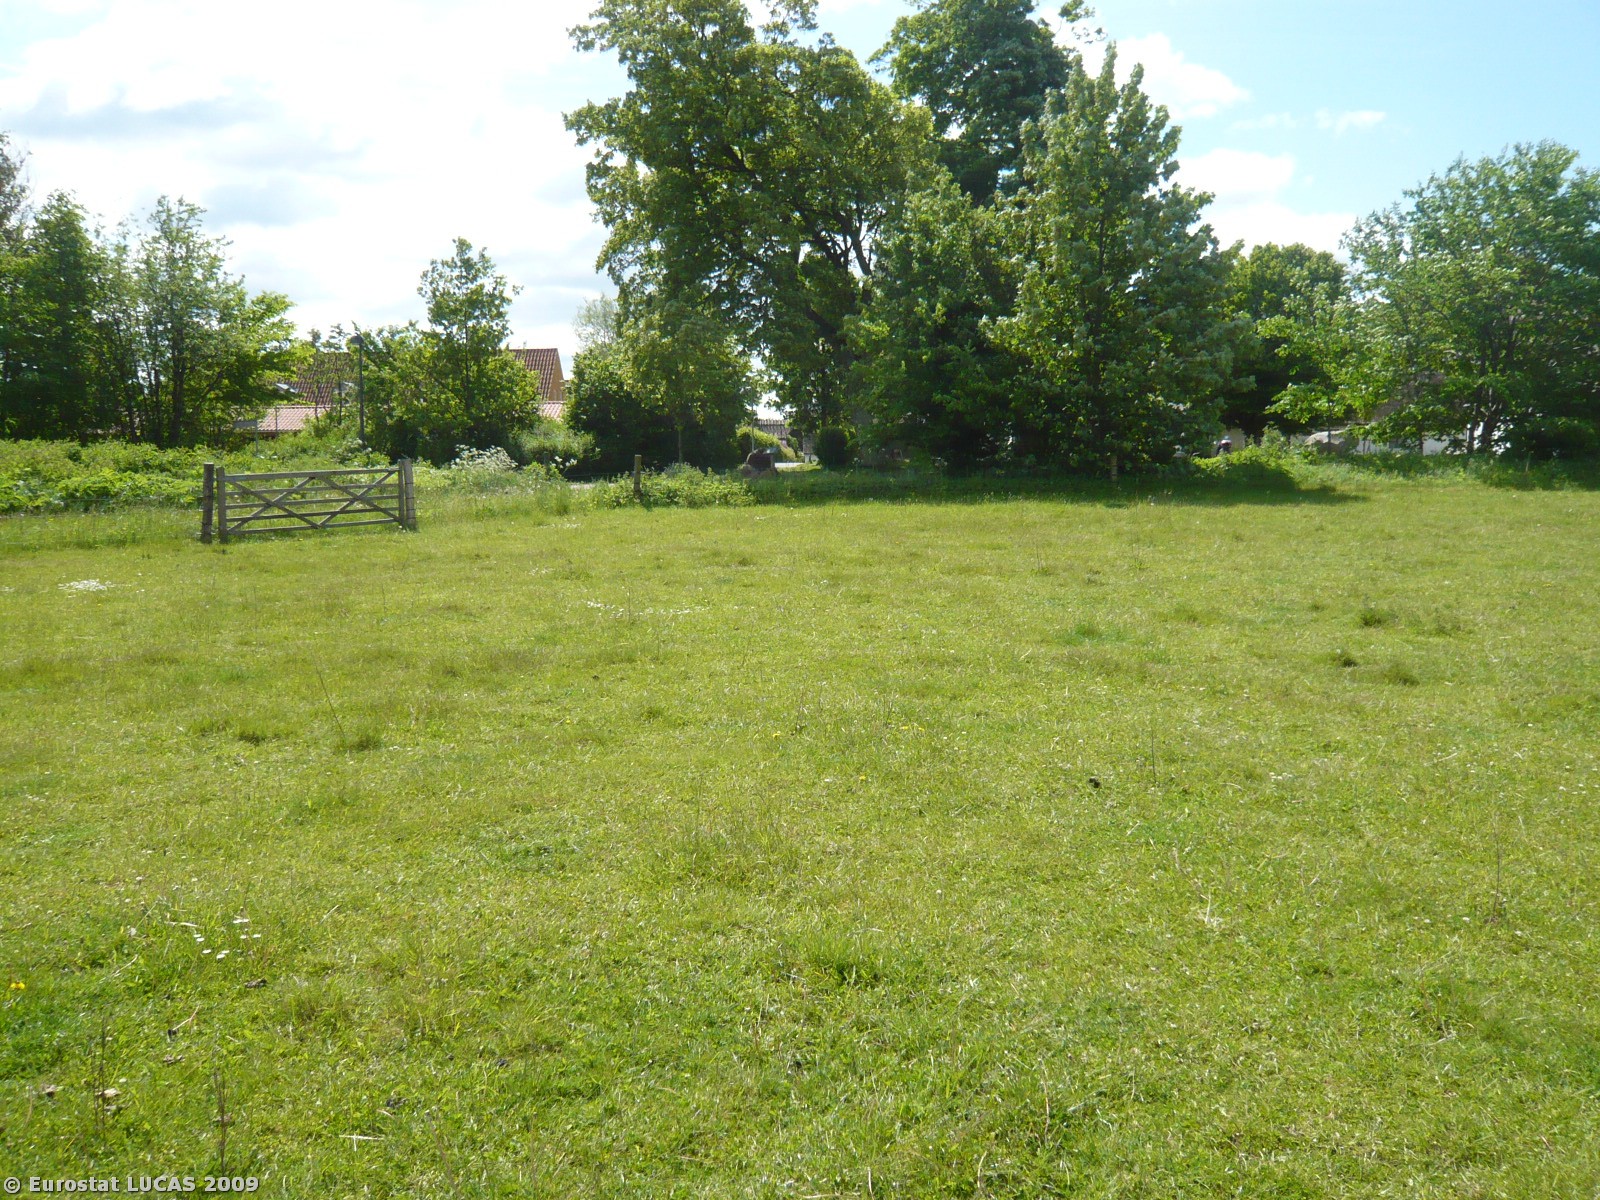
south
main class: Grassland
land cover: Grassland without tree/shrub cover
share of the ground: > 75 %
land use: Agriculture (excluding fallow land and kitchen gardens)
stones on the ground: < 10 %
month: May
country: DK
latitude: 55.7349
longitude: 12.3391
